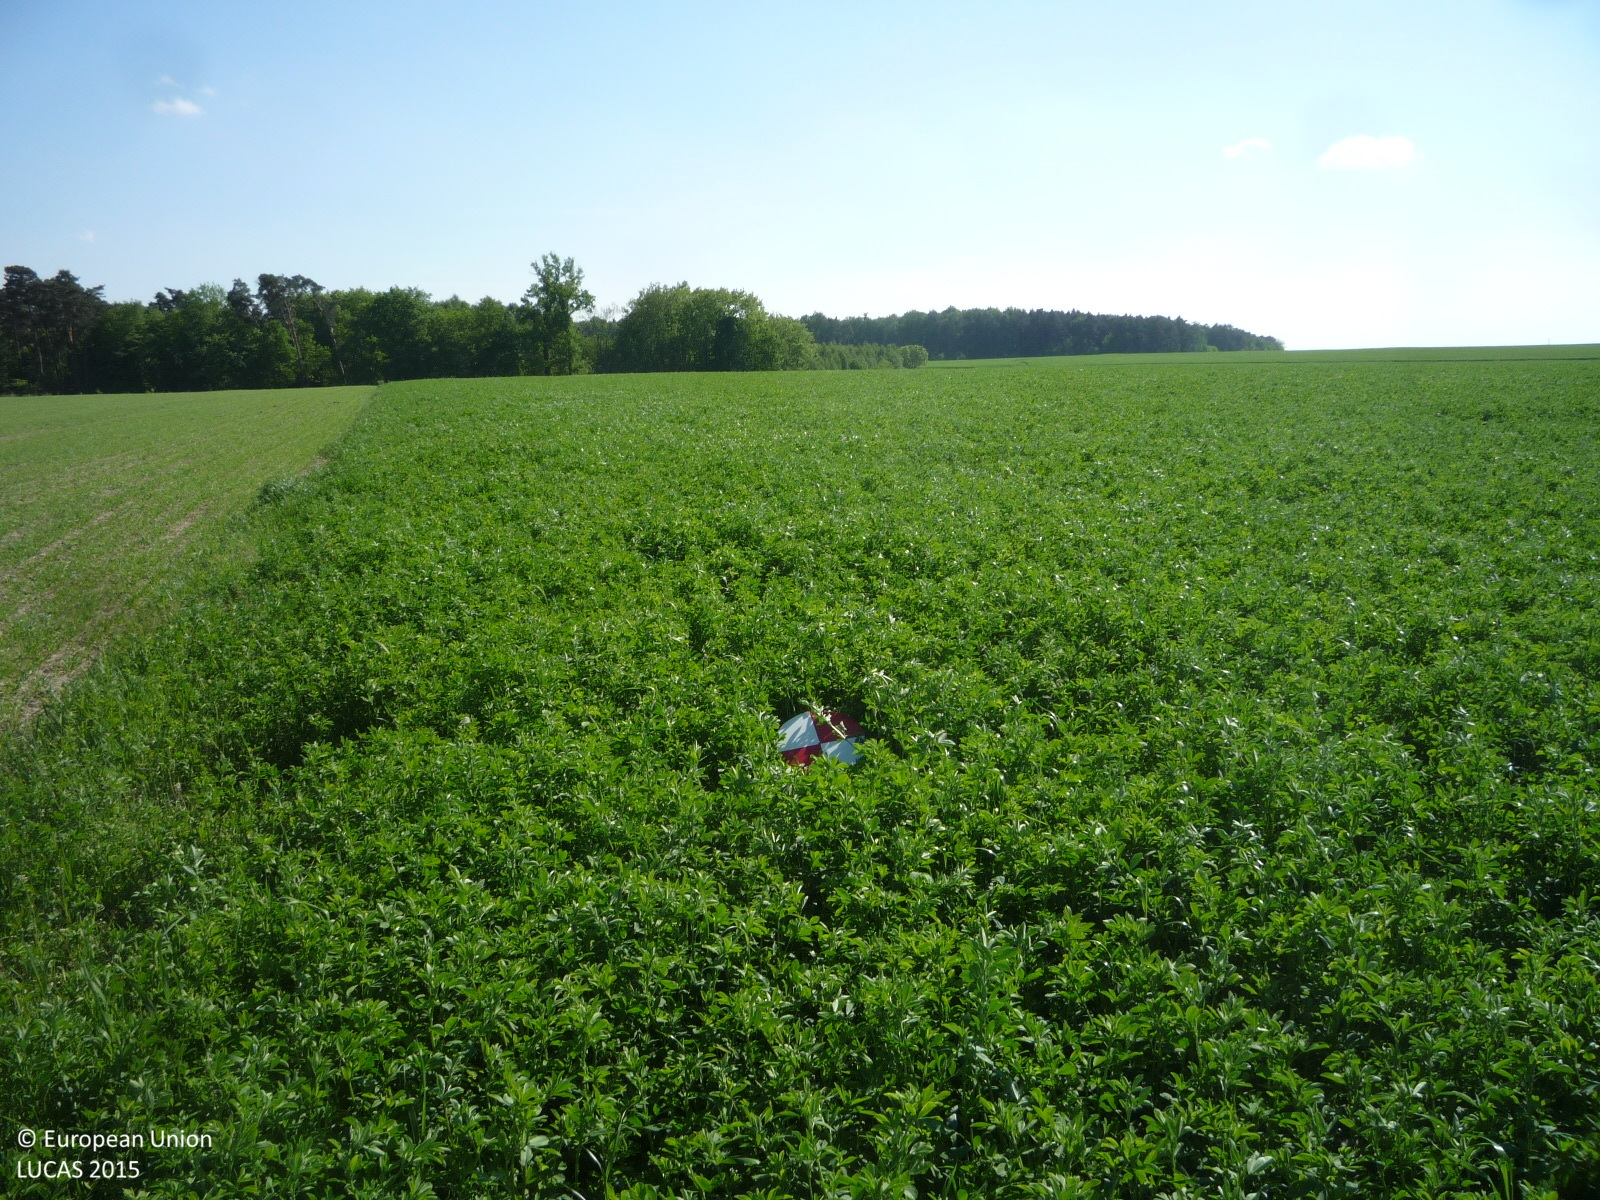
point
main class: Cropland
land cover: Lucerne
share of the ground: > 75 %
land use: Agriculture (excluding fallow land and kitchen gardens)
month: May
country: CZ
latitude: 50.3235
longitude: 14.6512
